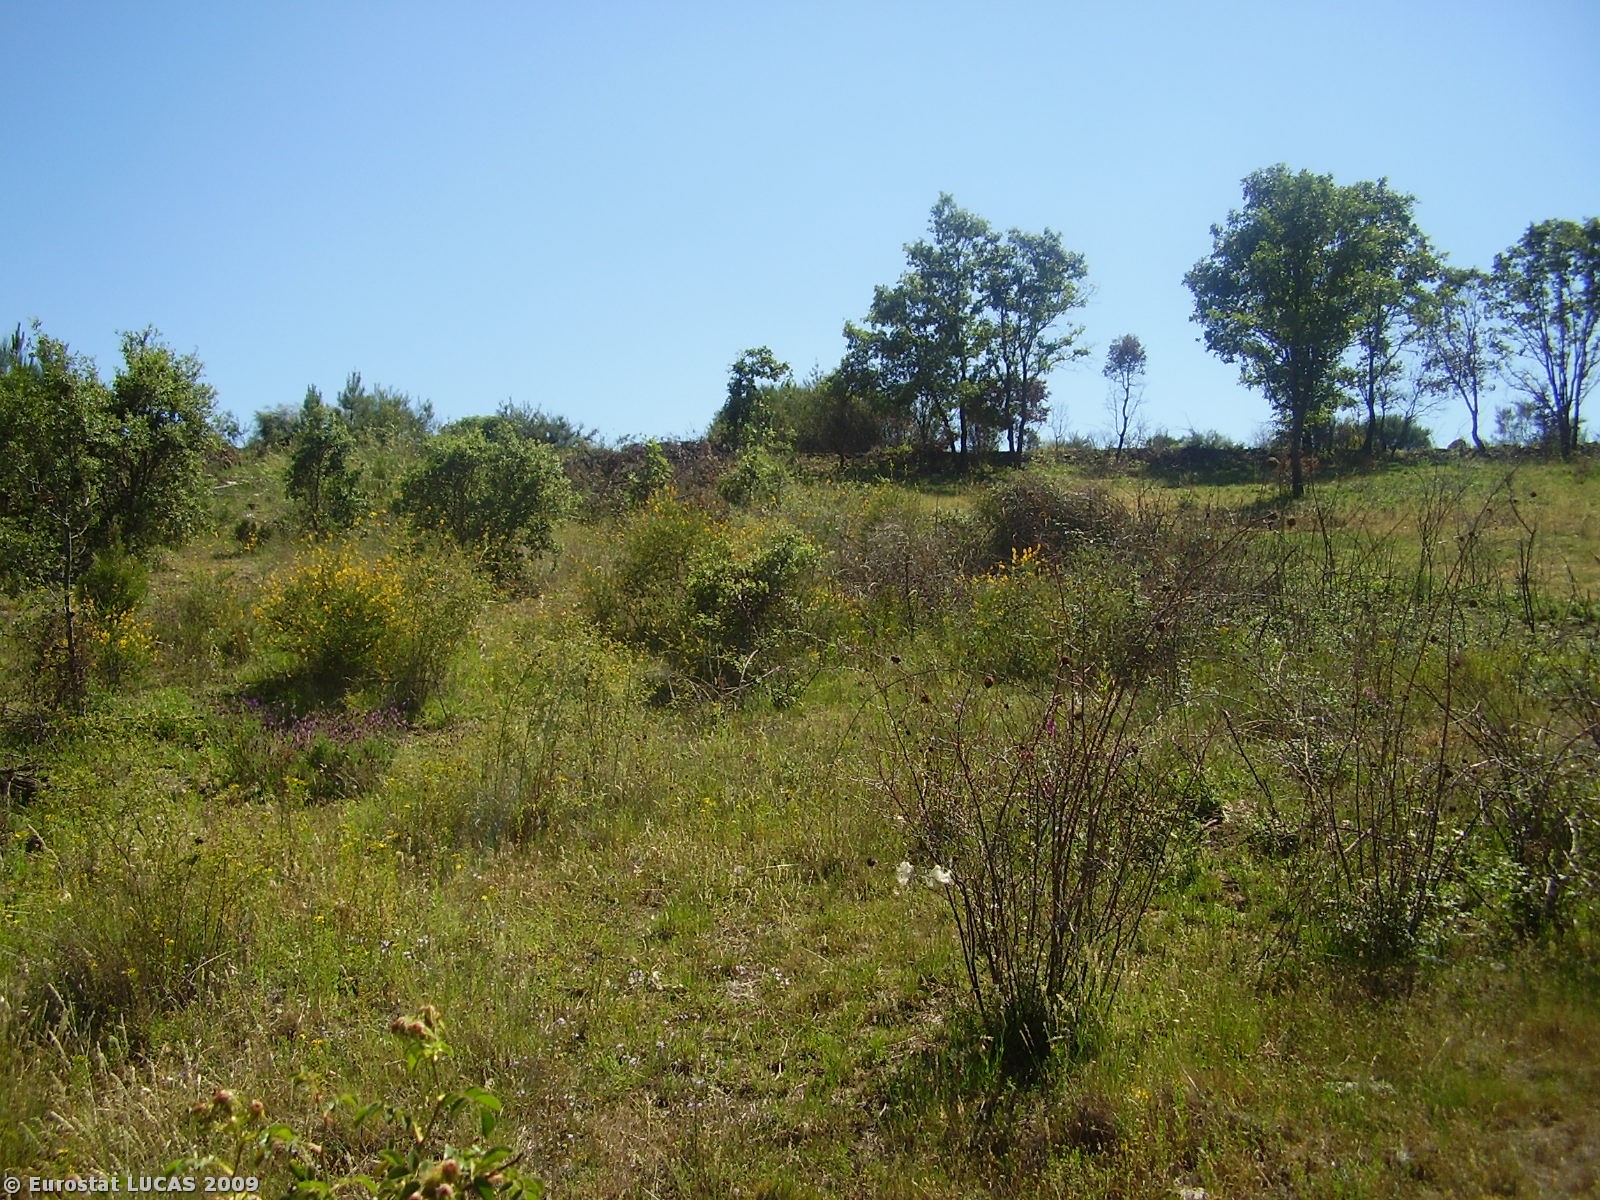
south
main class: Grassland
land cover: Spontaneously vegetated surfaces
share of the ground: > 75 %
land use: Nature reserves
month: June
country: PT
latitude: 41.7735
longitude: -6.5778
